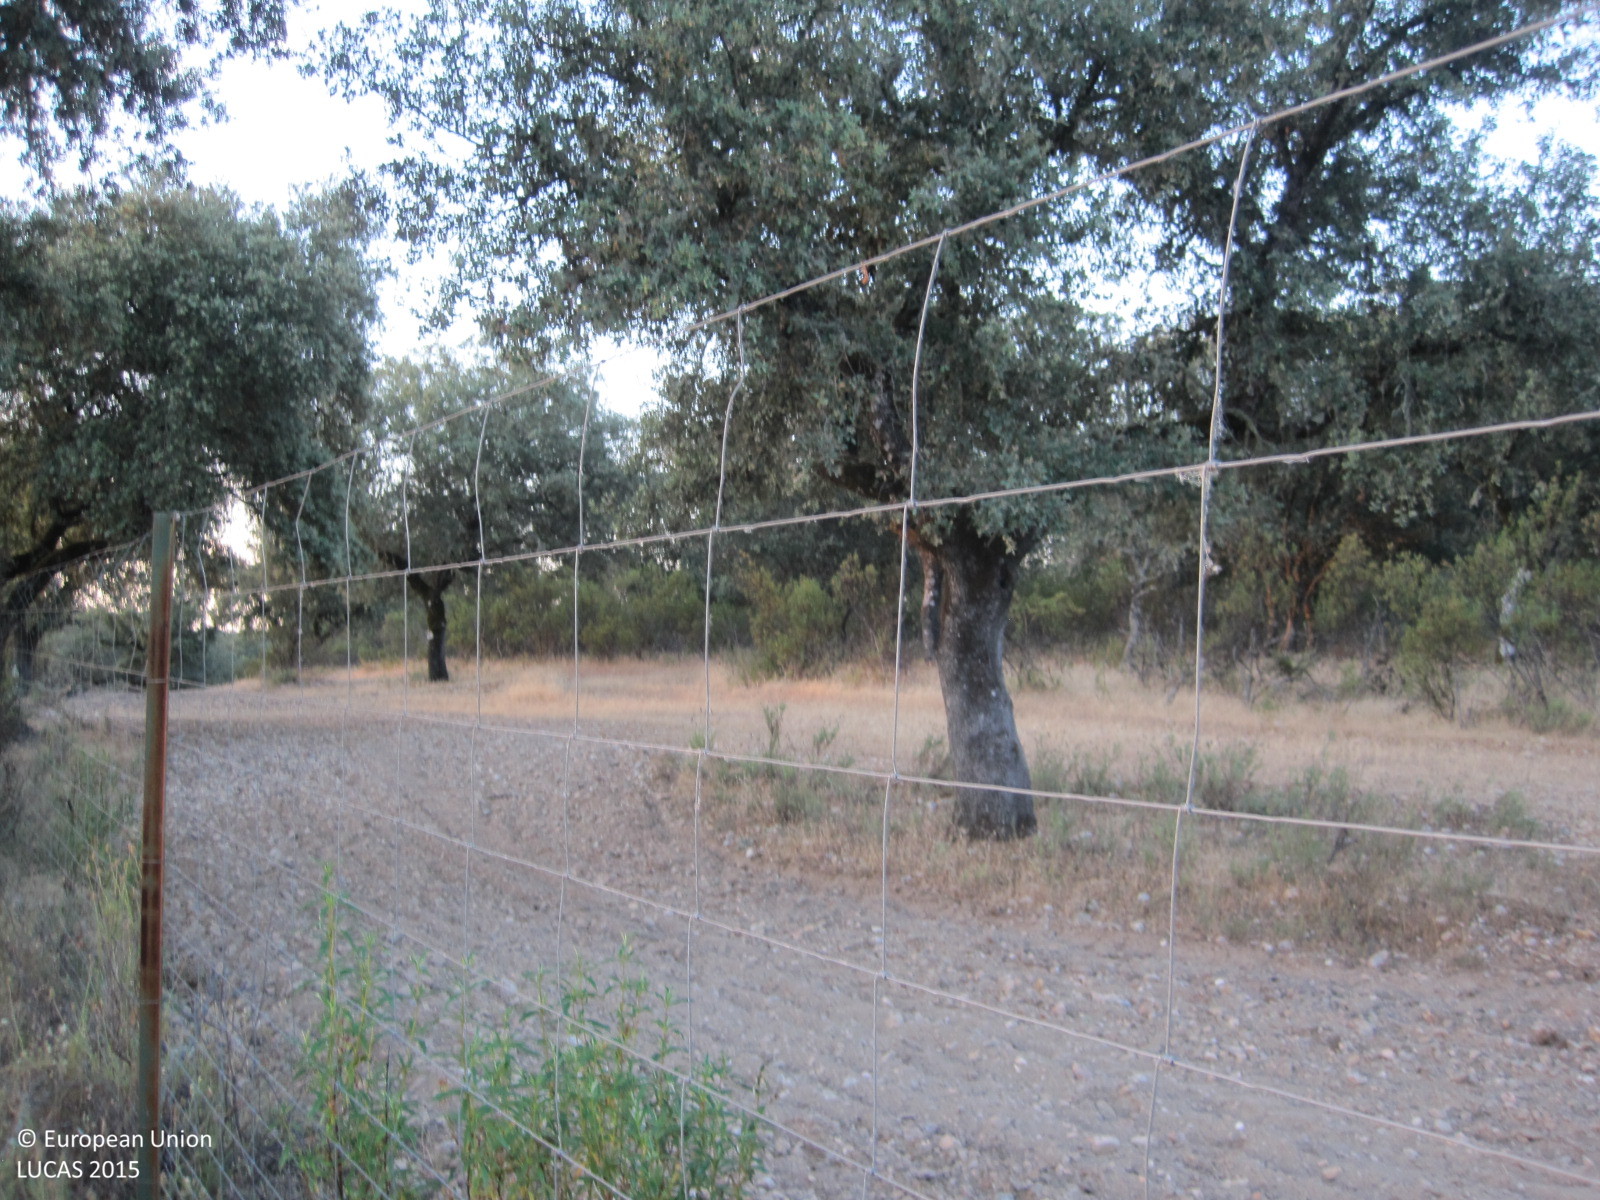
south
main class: Woodland
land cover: Broadleaved woodland
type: broadleaved evergreen forest
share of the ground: > 75 %
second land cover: Shrubland without tree cover
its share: 50 - 75 %
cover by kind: broadleaved forest trees 75 %, shrubs 20 %, herbaceous plants 5 %
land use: Forestry
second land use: Agriculture (excluding fallow land and kitchen gardens)
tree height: < 5 m
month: June
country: ES
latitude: 40.0544
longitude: -5.1651
